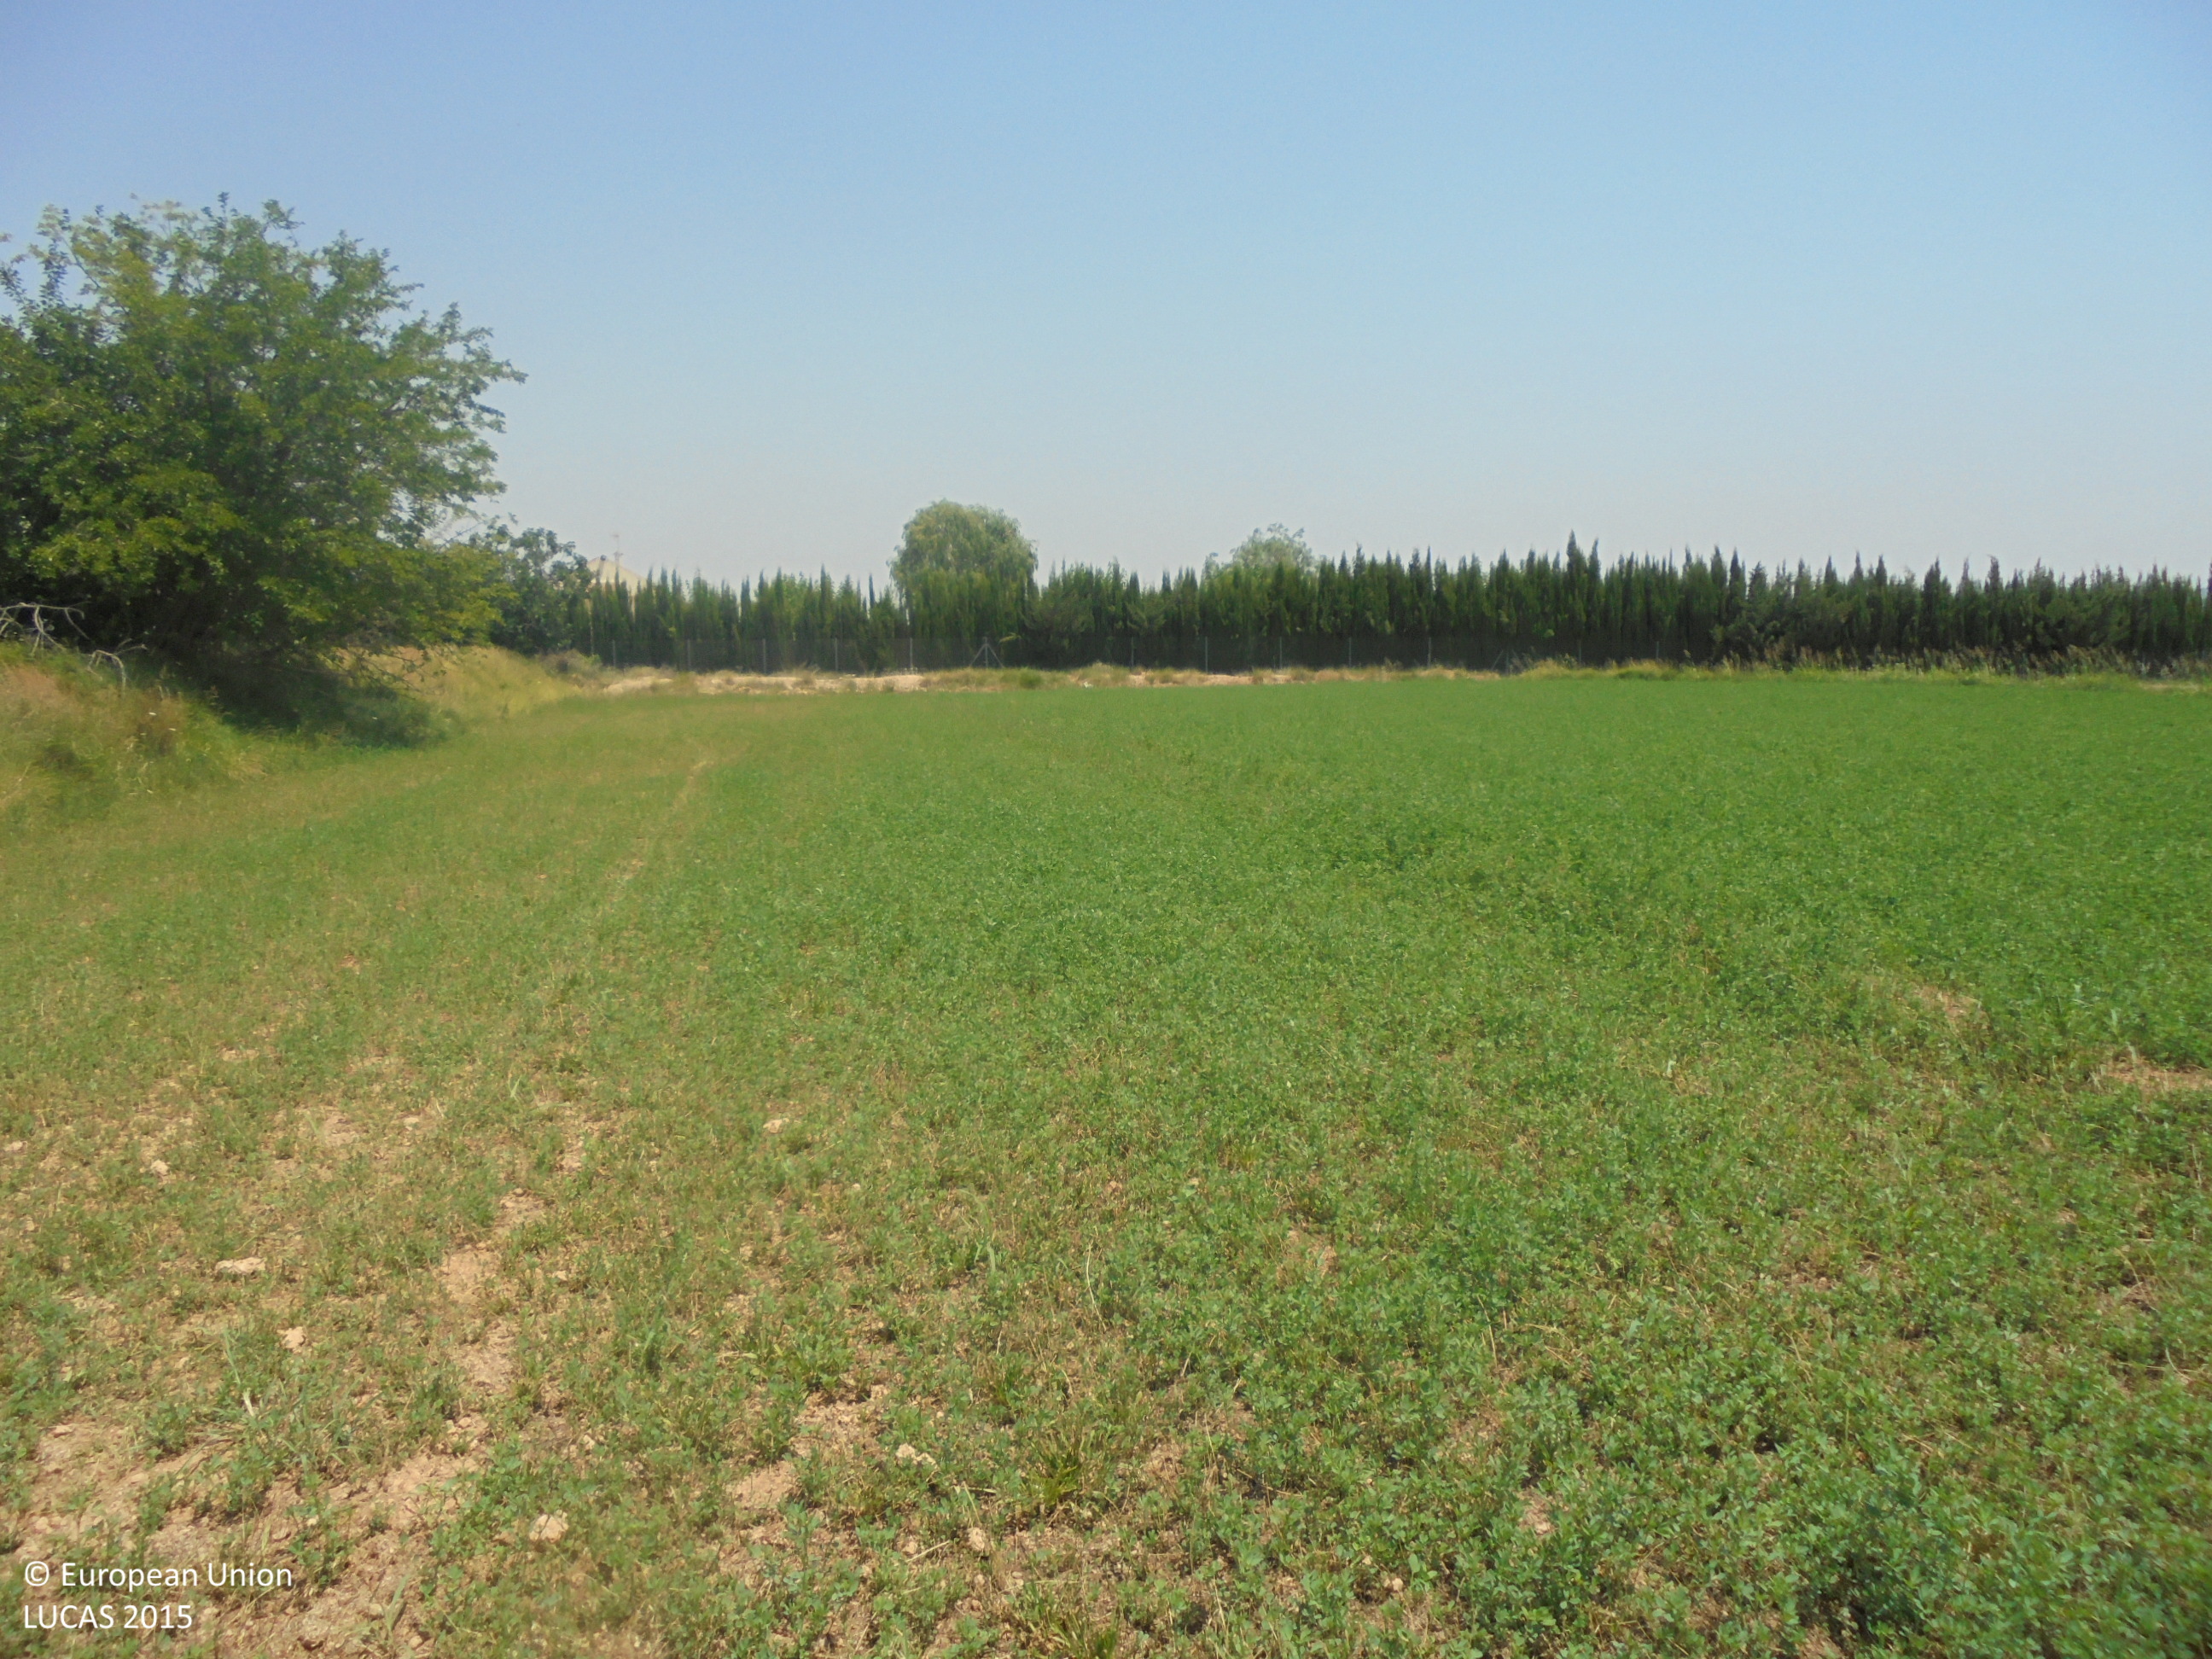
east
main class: Cropland
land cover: Lucerne
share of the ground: 25 - 50 %
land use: Agriculture (excluding fallow land and kitchen gardens)
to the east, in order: Lucerne; Electric lines; Lucerne; Grassland without tree/shrub cover; Ditches and canals; Grass margins; Fences; Conifer hedges; Groves; Artificial constructions in urban areas; Tracks; Grass margins; Fences; Spontaneously vegetated surfaces
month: July
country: ES
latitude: 38.4895
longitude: -1.6755
